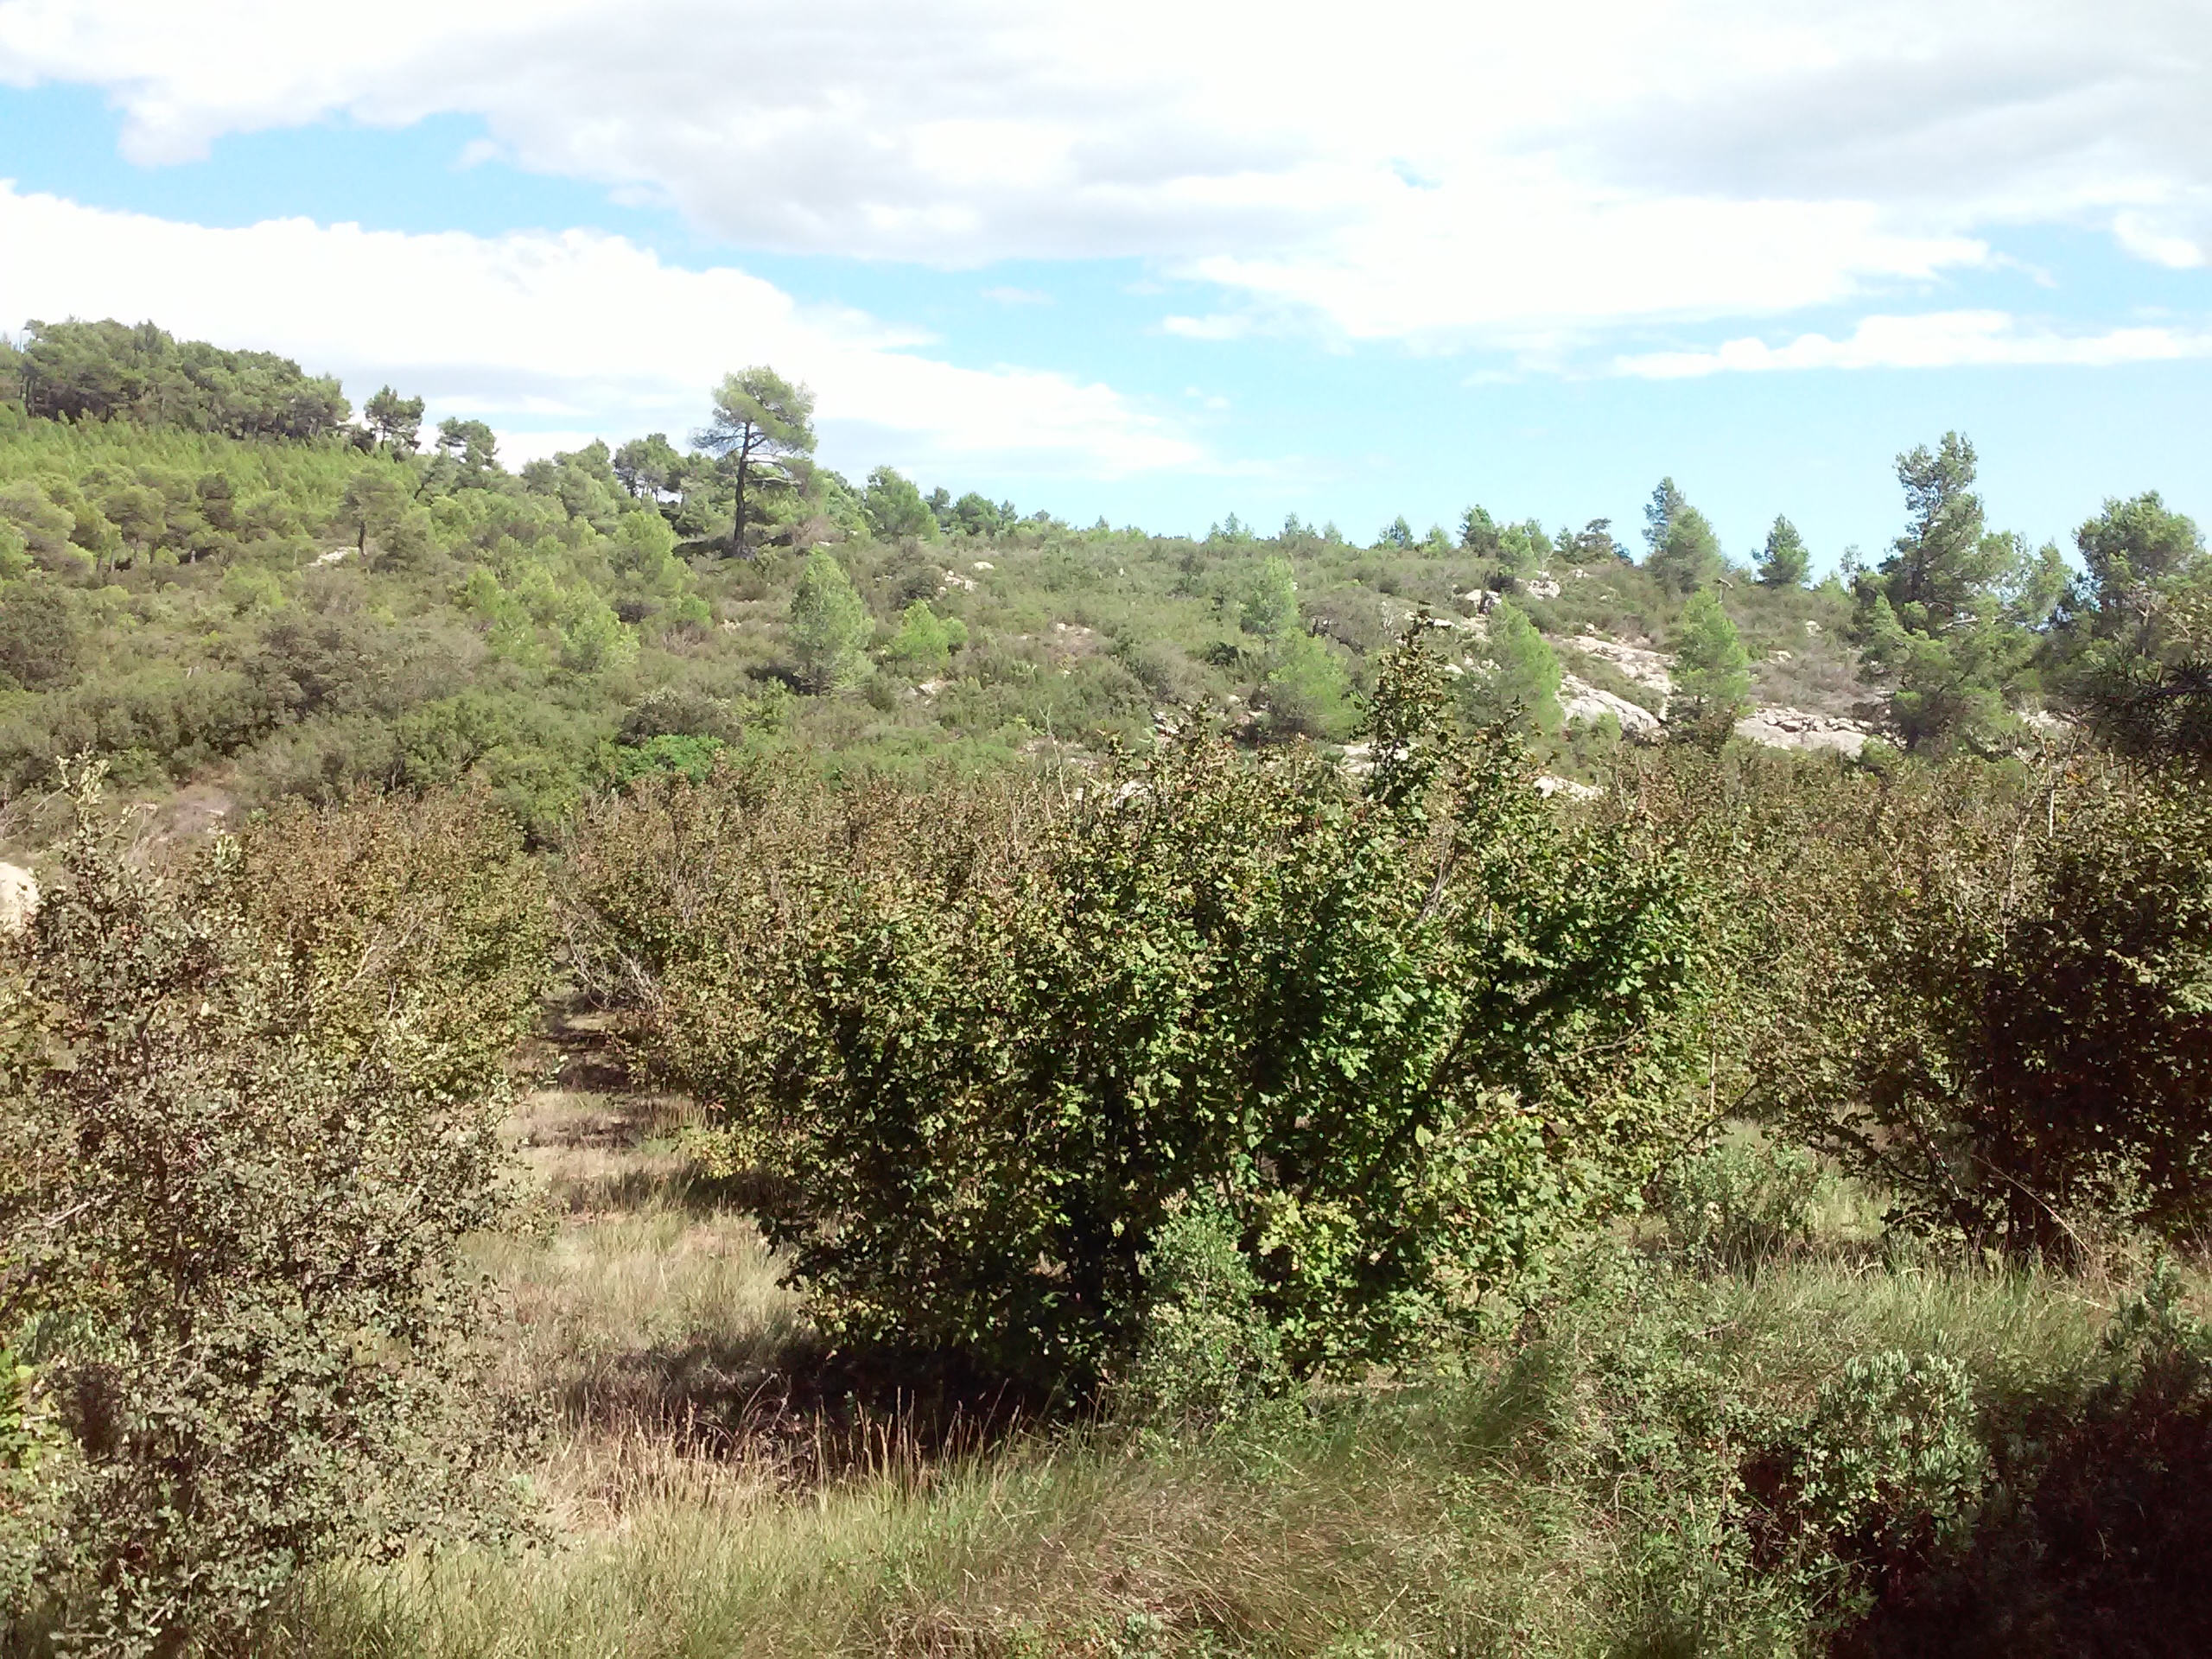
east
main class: Woodland
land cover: Pine dominated coniferous woodland
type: coniferous forest of the mediterranean region
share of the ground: > 75 %
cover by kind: coniferous forest trees 80 %, shrubs 20 %
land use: Semi-natural and natural areas not in use
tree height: > 5 m
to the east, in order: Pine dominated coniferous woodland; Tracks; Shruby margins; Nuts trees; Shrubland with sparse tree cover; Tracks; Shrubland with sparse tree cover; Tracks; Shrubland with sparse tree cover; Pine dominated mixed woodland; Pine dominated coniferous woodland
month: August
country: ES
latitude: 41.0549
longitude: 0.8193
